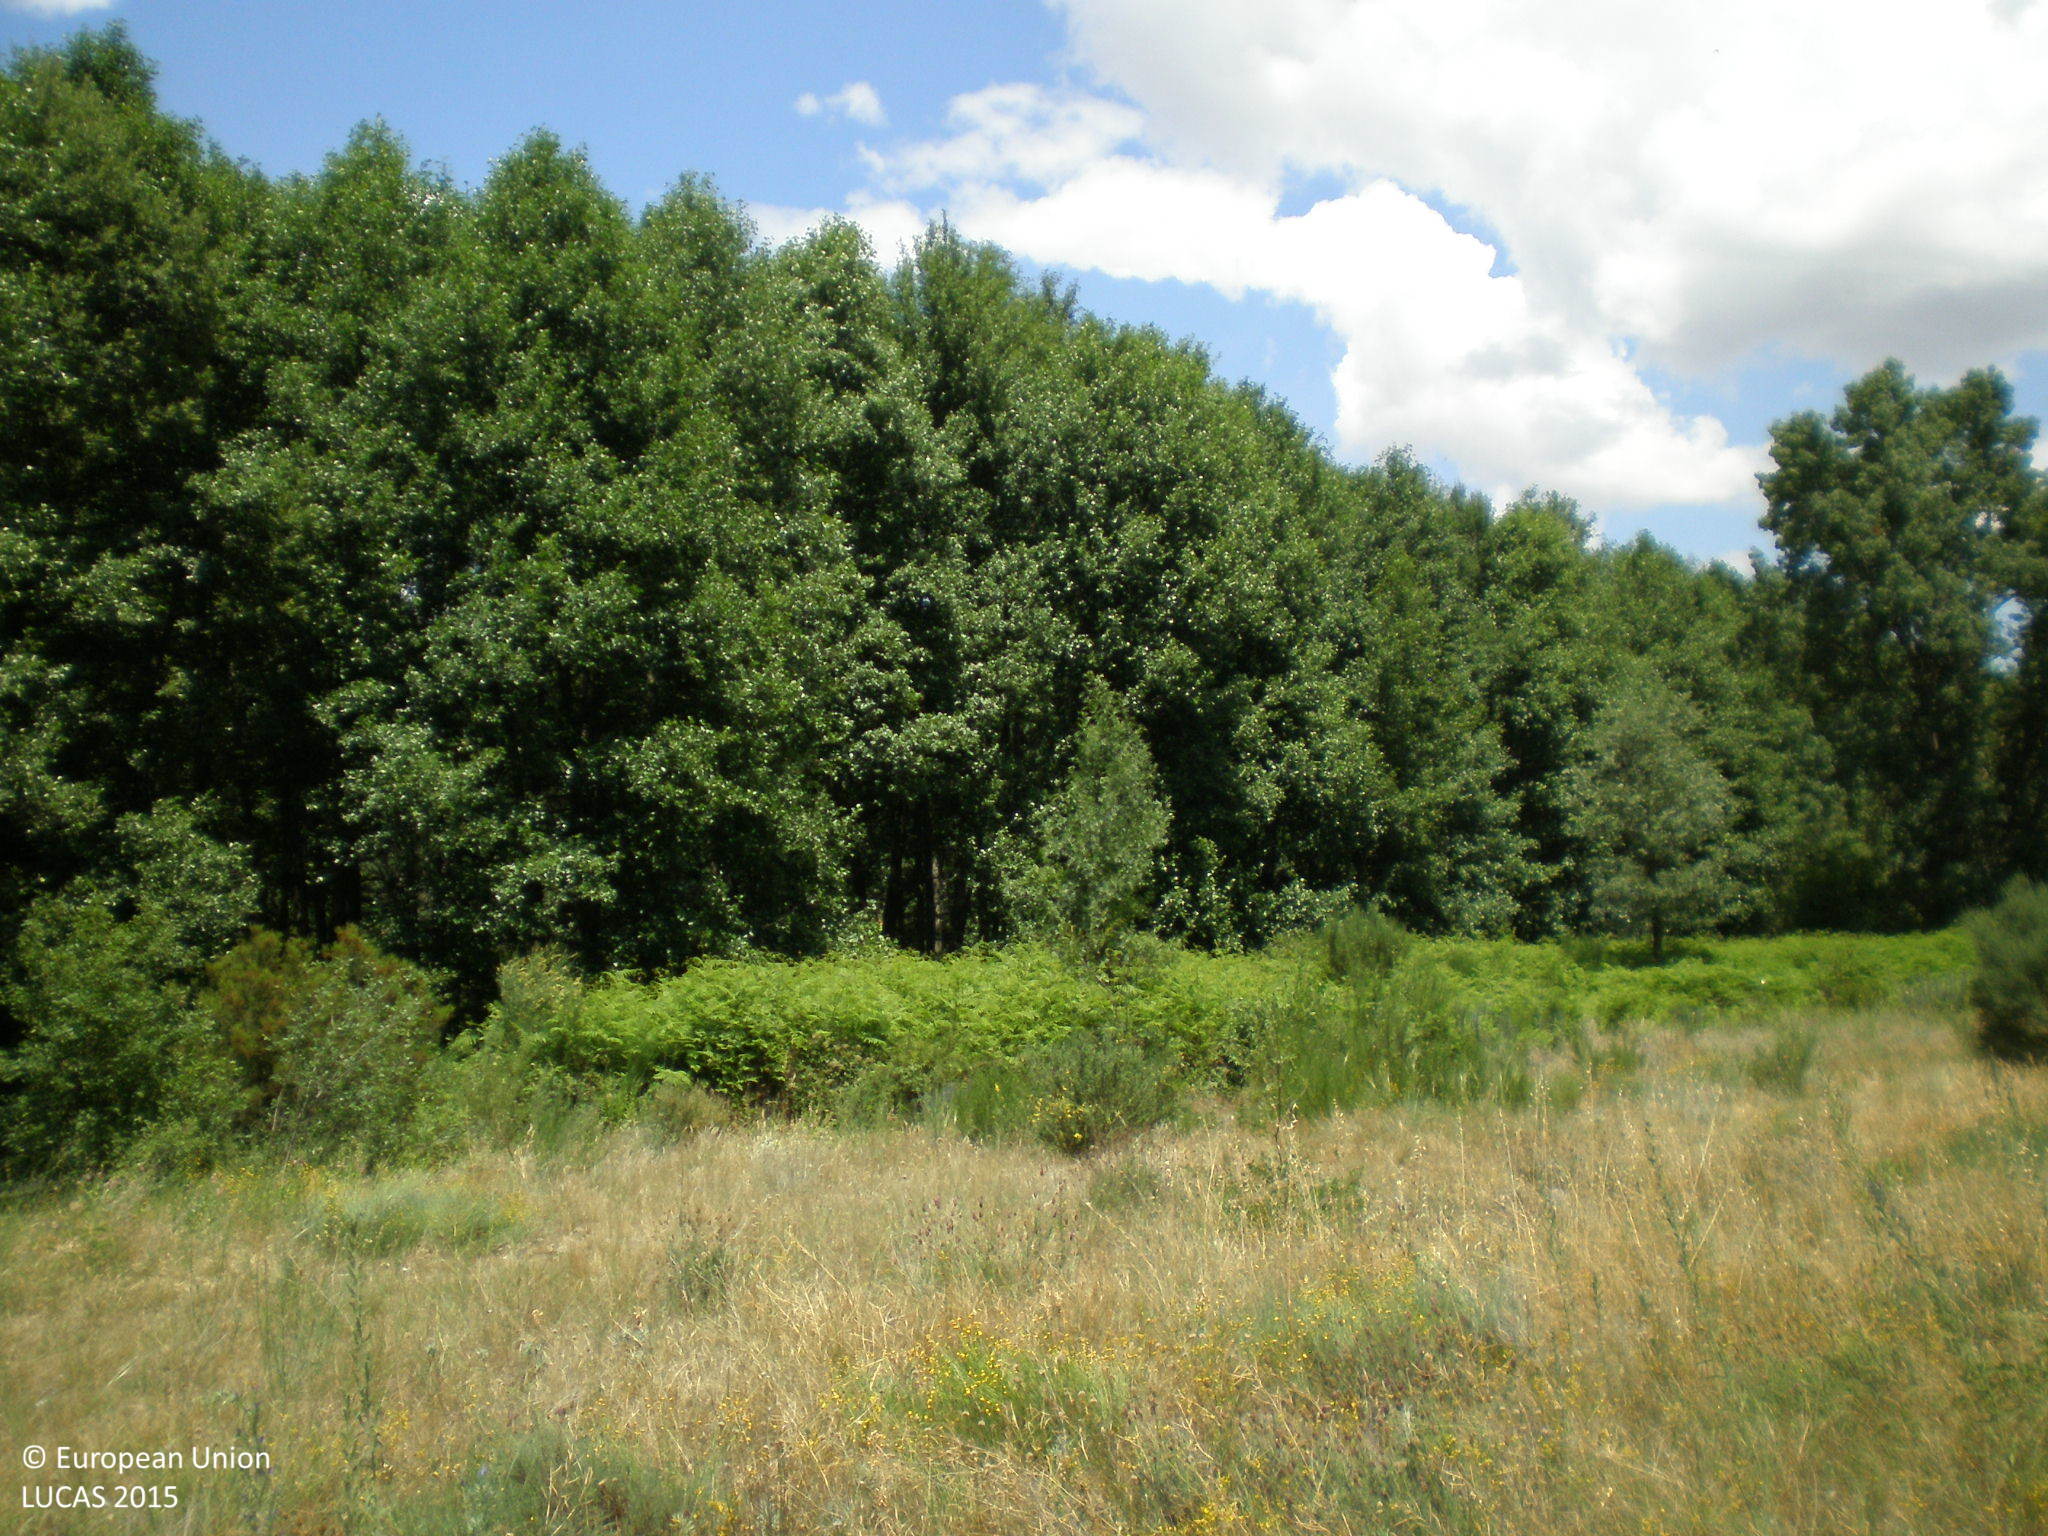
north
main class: Grassland
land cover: Grassland without tree/shrub cover
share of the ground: > 75 %
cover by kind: herbaceous plants 100 %
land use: Semi-natural and natural areas not in use
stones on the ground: < 10 %
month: June
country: ES
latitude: 40.3430
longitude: -5.5465
